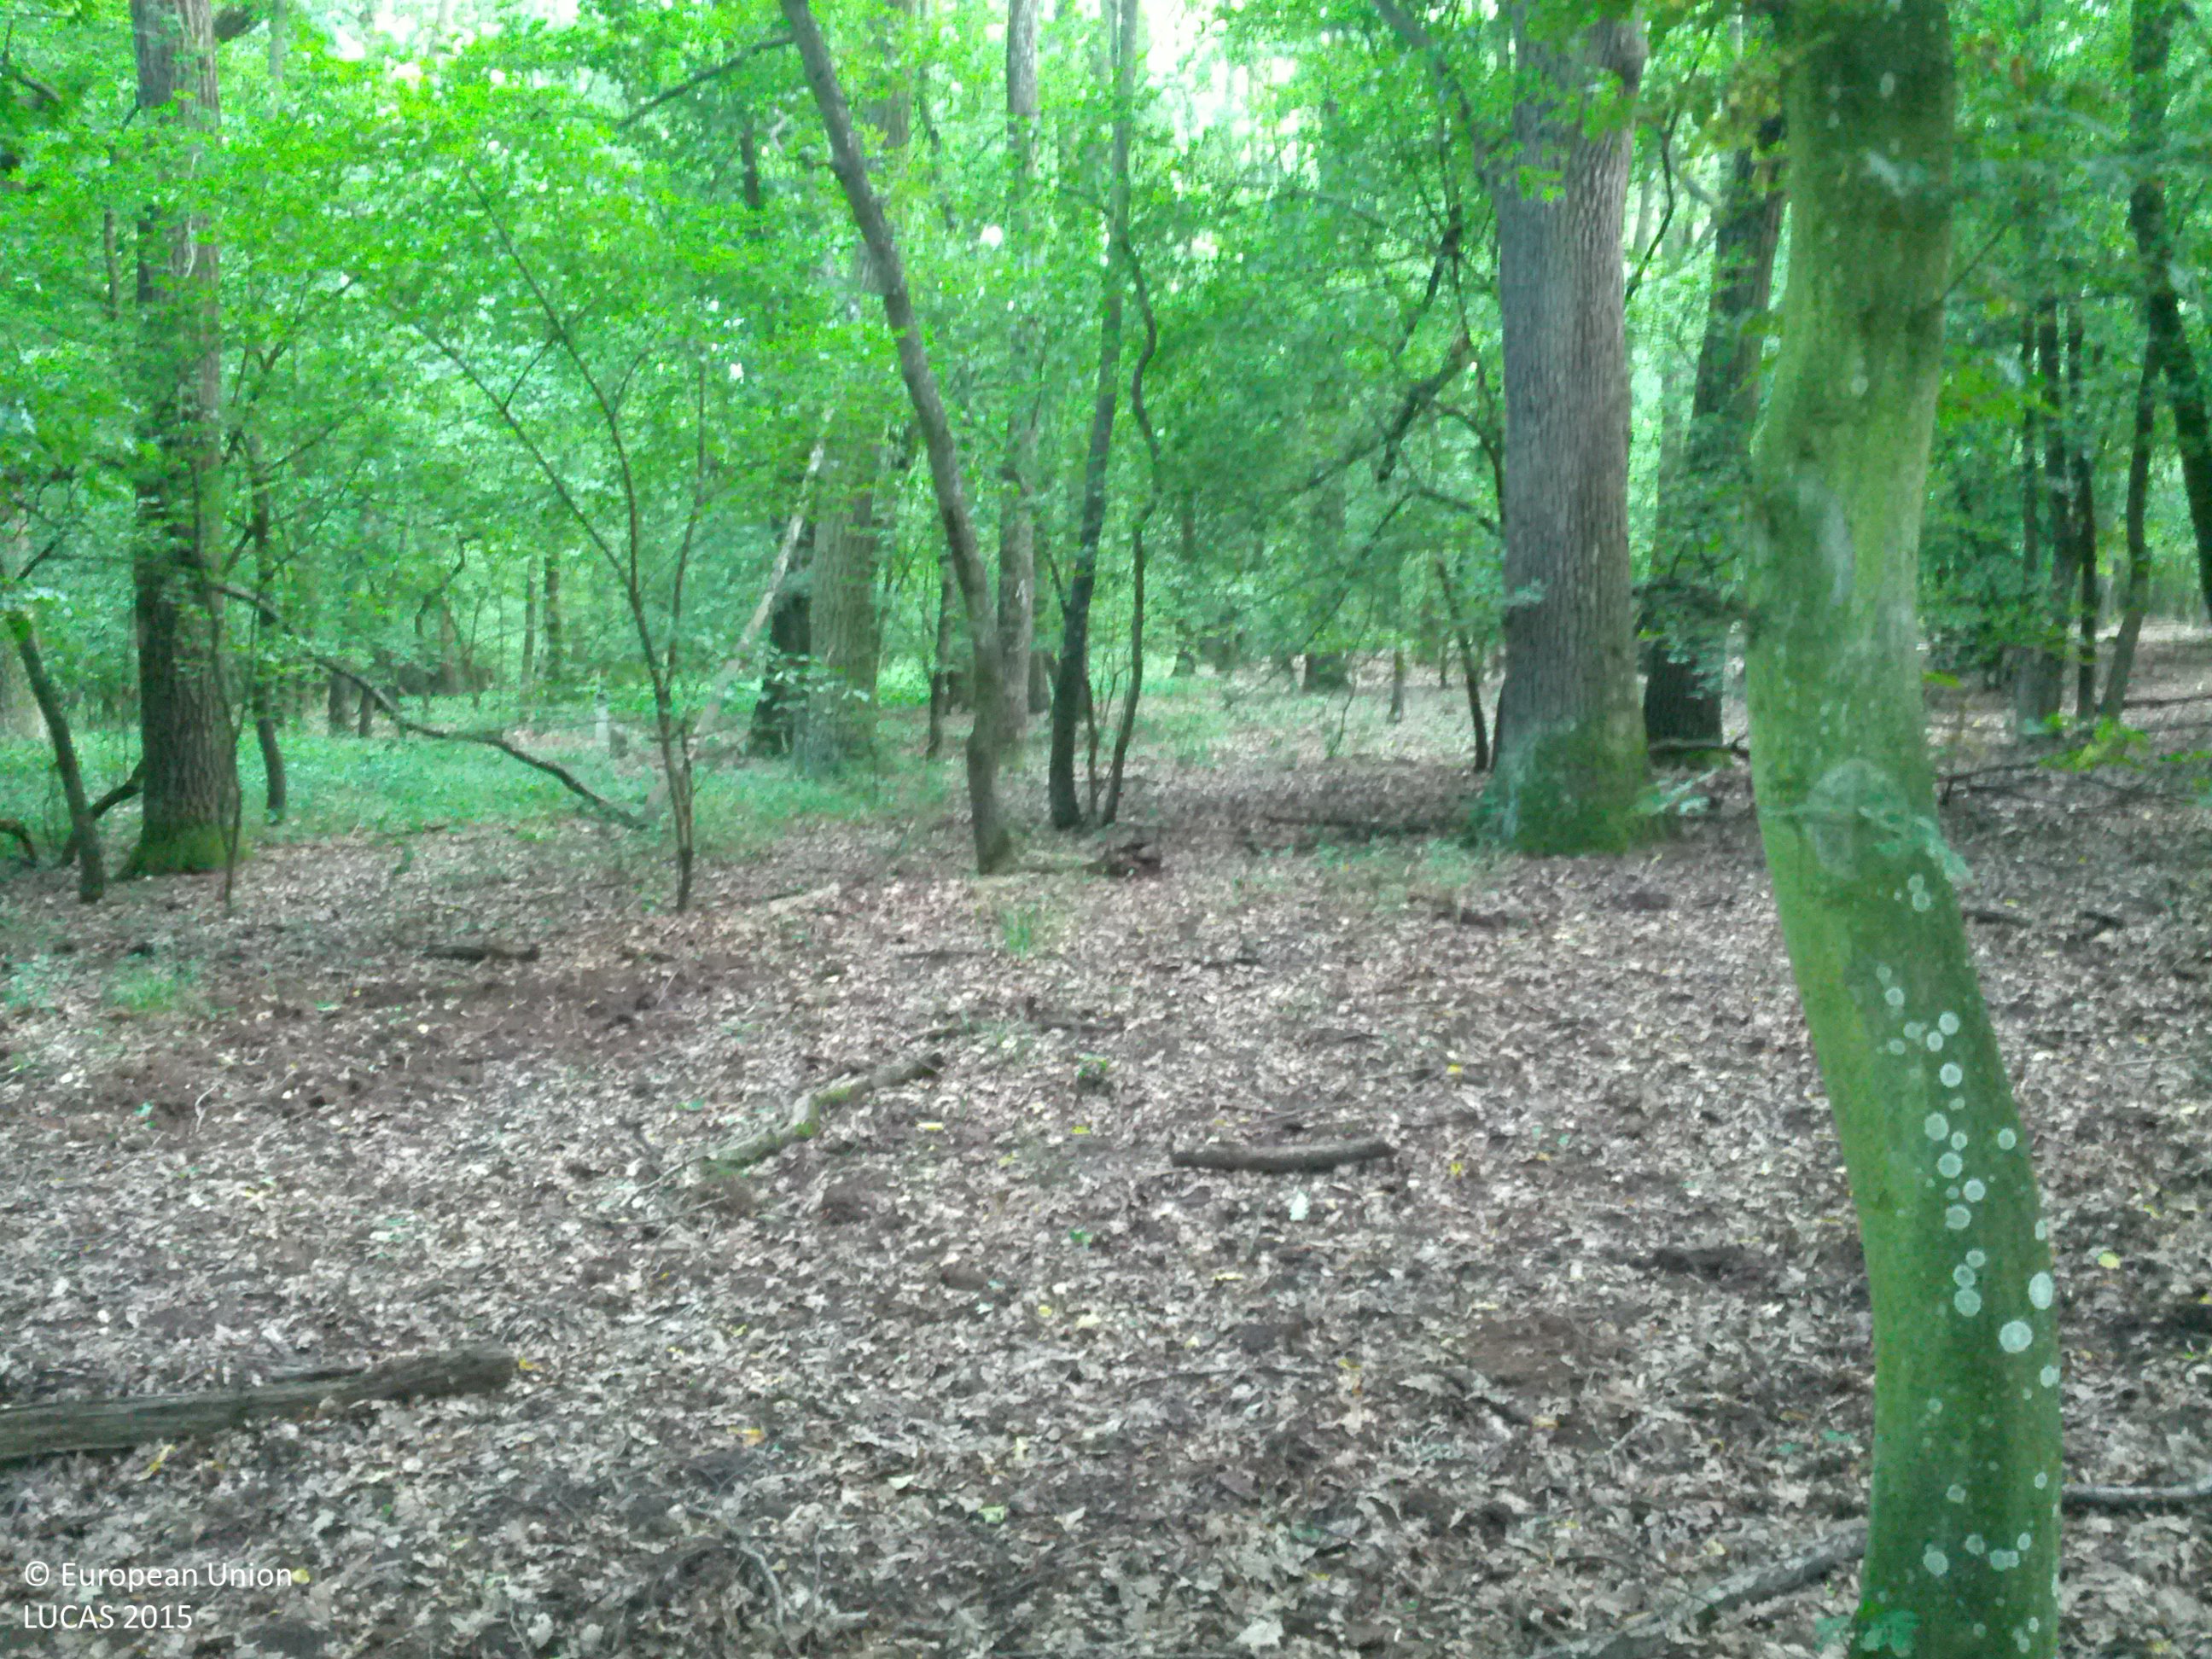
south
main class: Woodland
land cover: Broadleaved woodland
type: beech forest
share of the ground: > 75 %
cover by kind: broadleaved forest trees 90 %, unconsolidated bare surface 10 %
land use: Forestry
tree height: > 5 m
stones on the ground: < 10 %
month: June
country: AT
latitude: 48.4236
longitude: 16.5873
